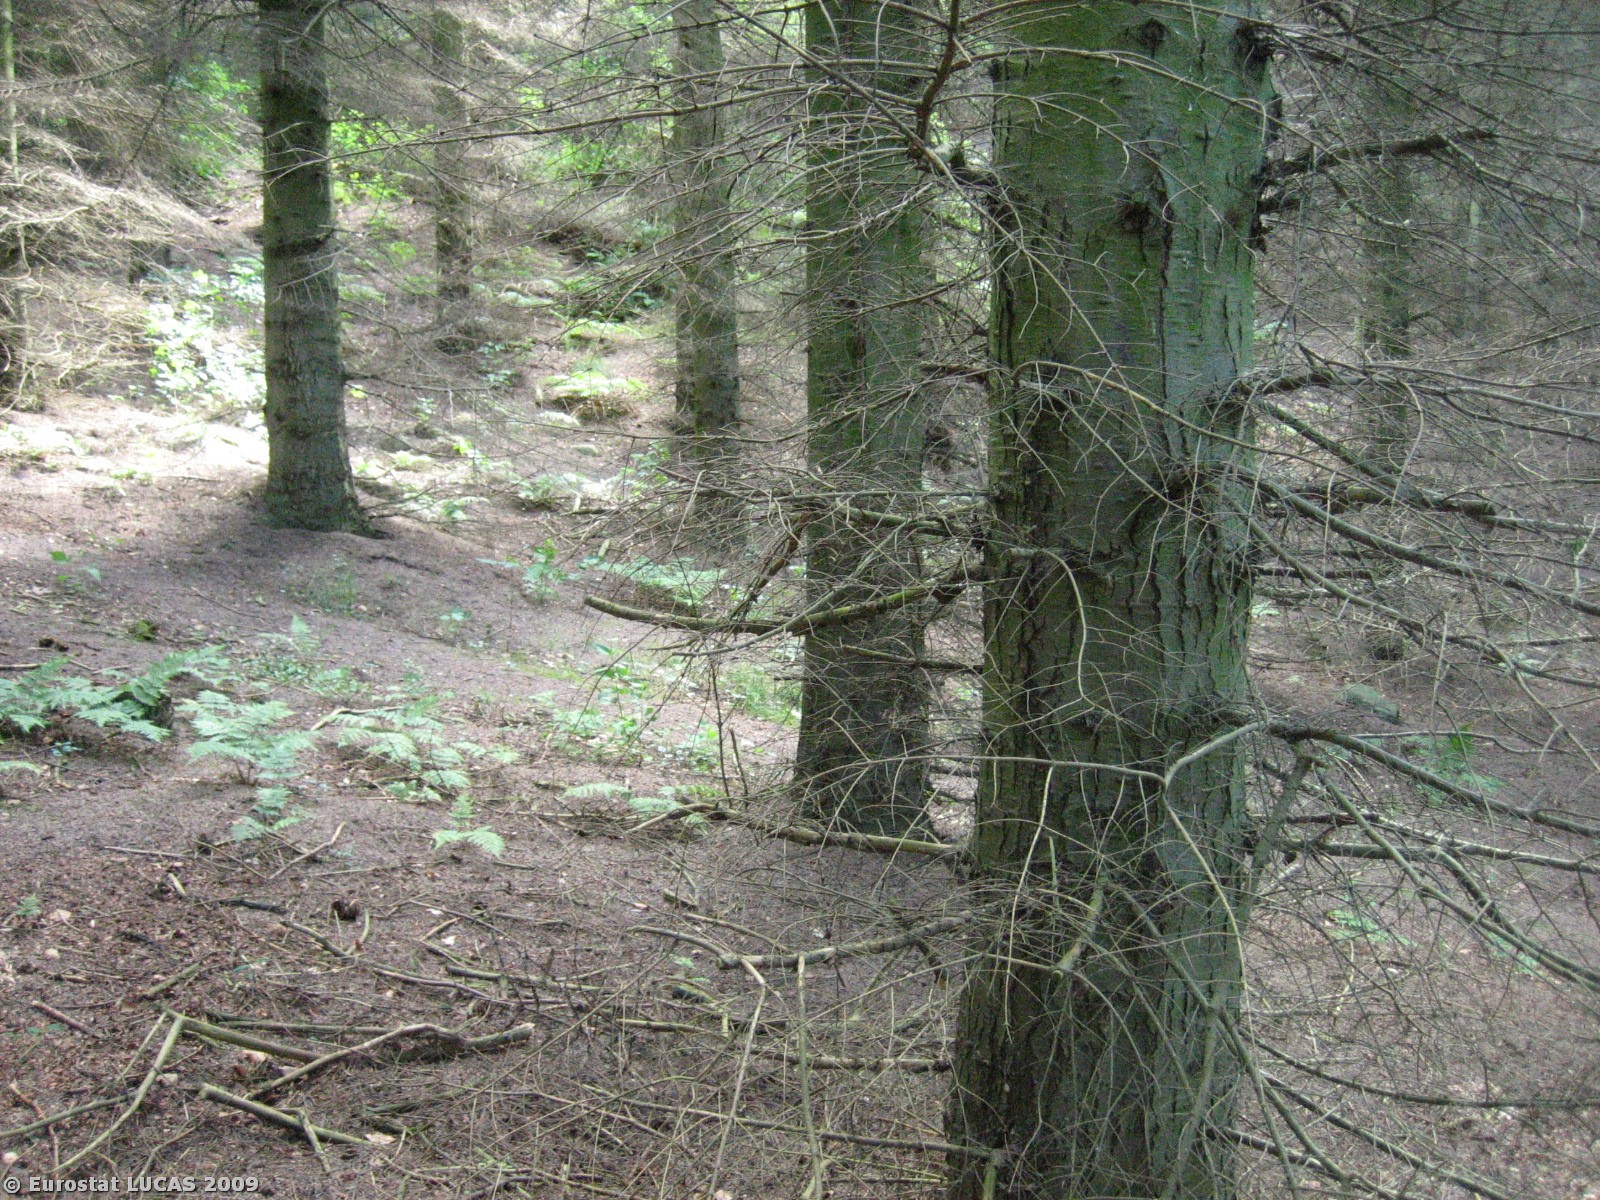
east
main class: Woodland
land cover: Coniferous woodland
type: hemiboreal forest and nemoral coniferous forest and mixed broadleaved-coniferous forest
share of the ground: > 75 %
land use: Forestry
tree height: > 5 m
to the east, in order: Coniferous woodland; Tracks; Coniferous woodland; Tracks; Broadleaved woodland; Maize; Grass margins; Grassland with sparse tree/shrub cover
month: June
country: DK
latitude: 55.7922
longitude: 9.8566
